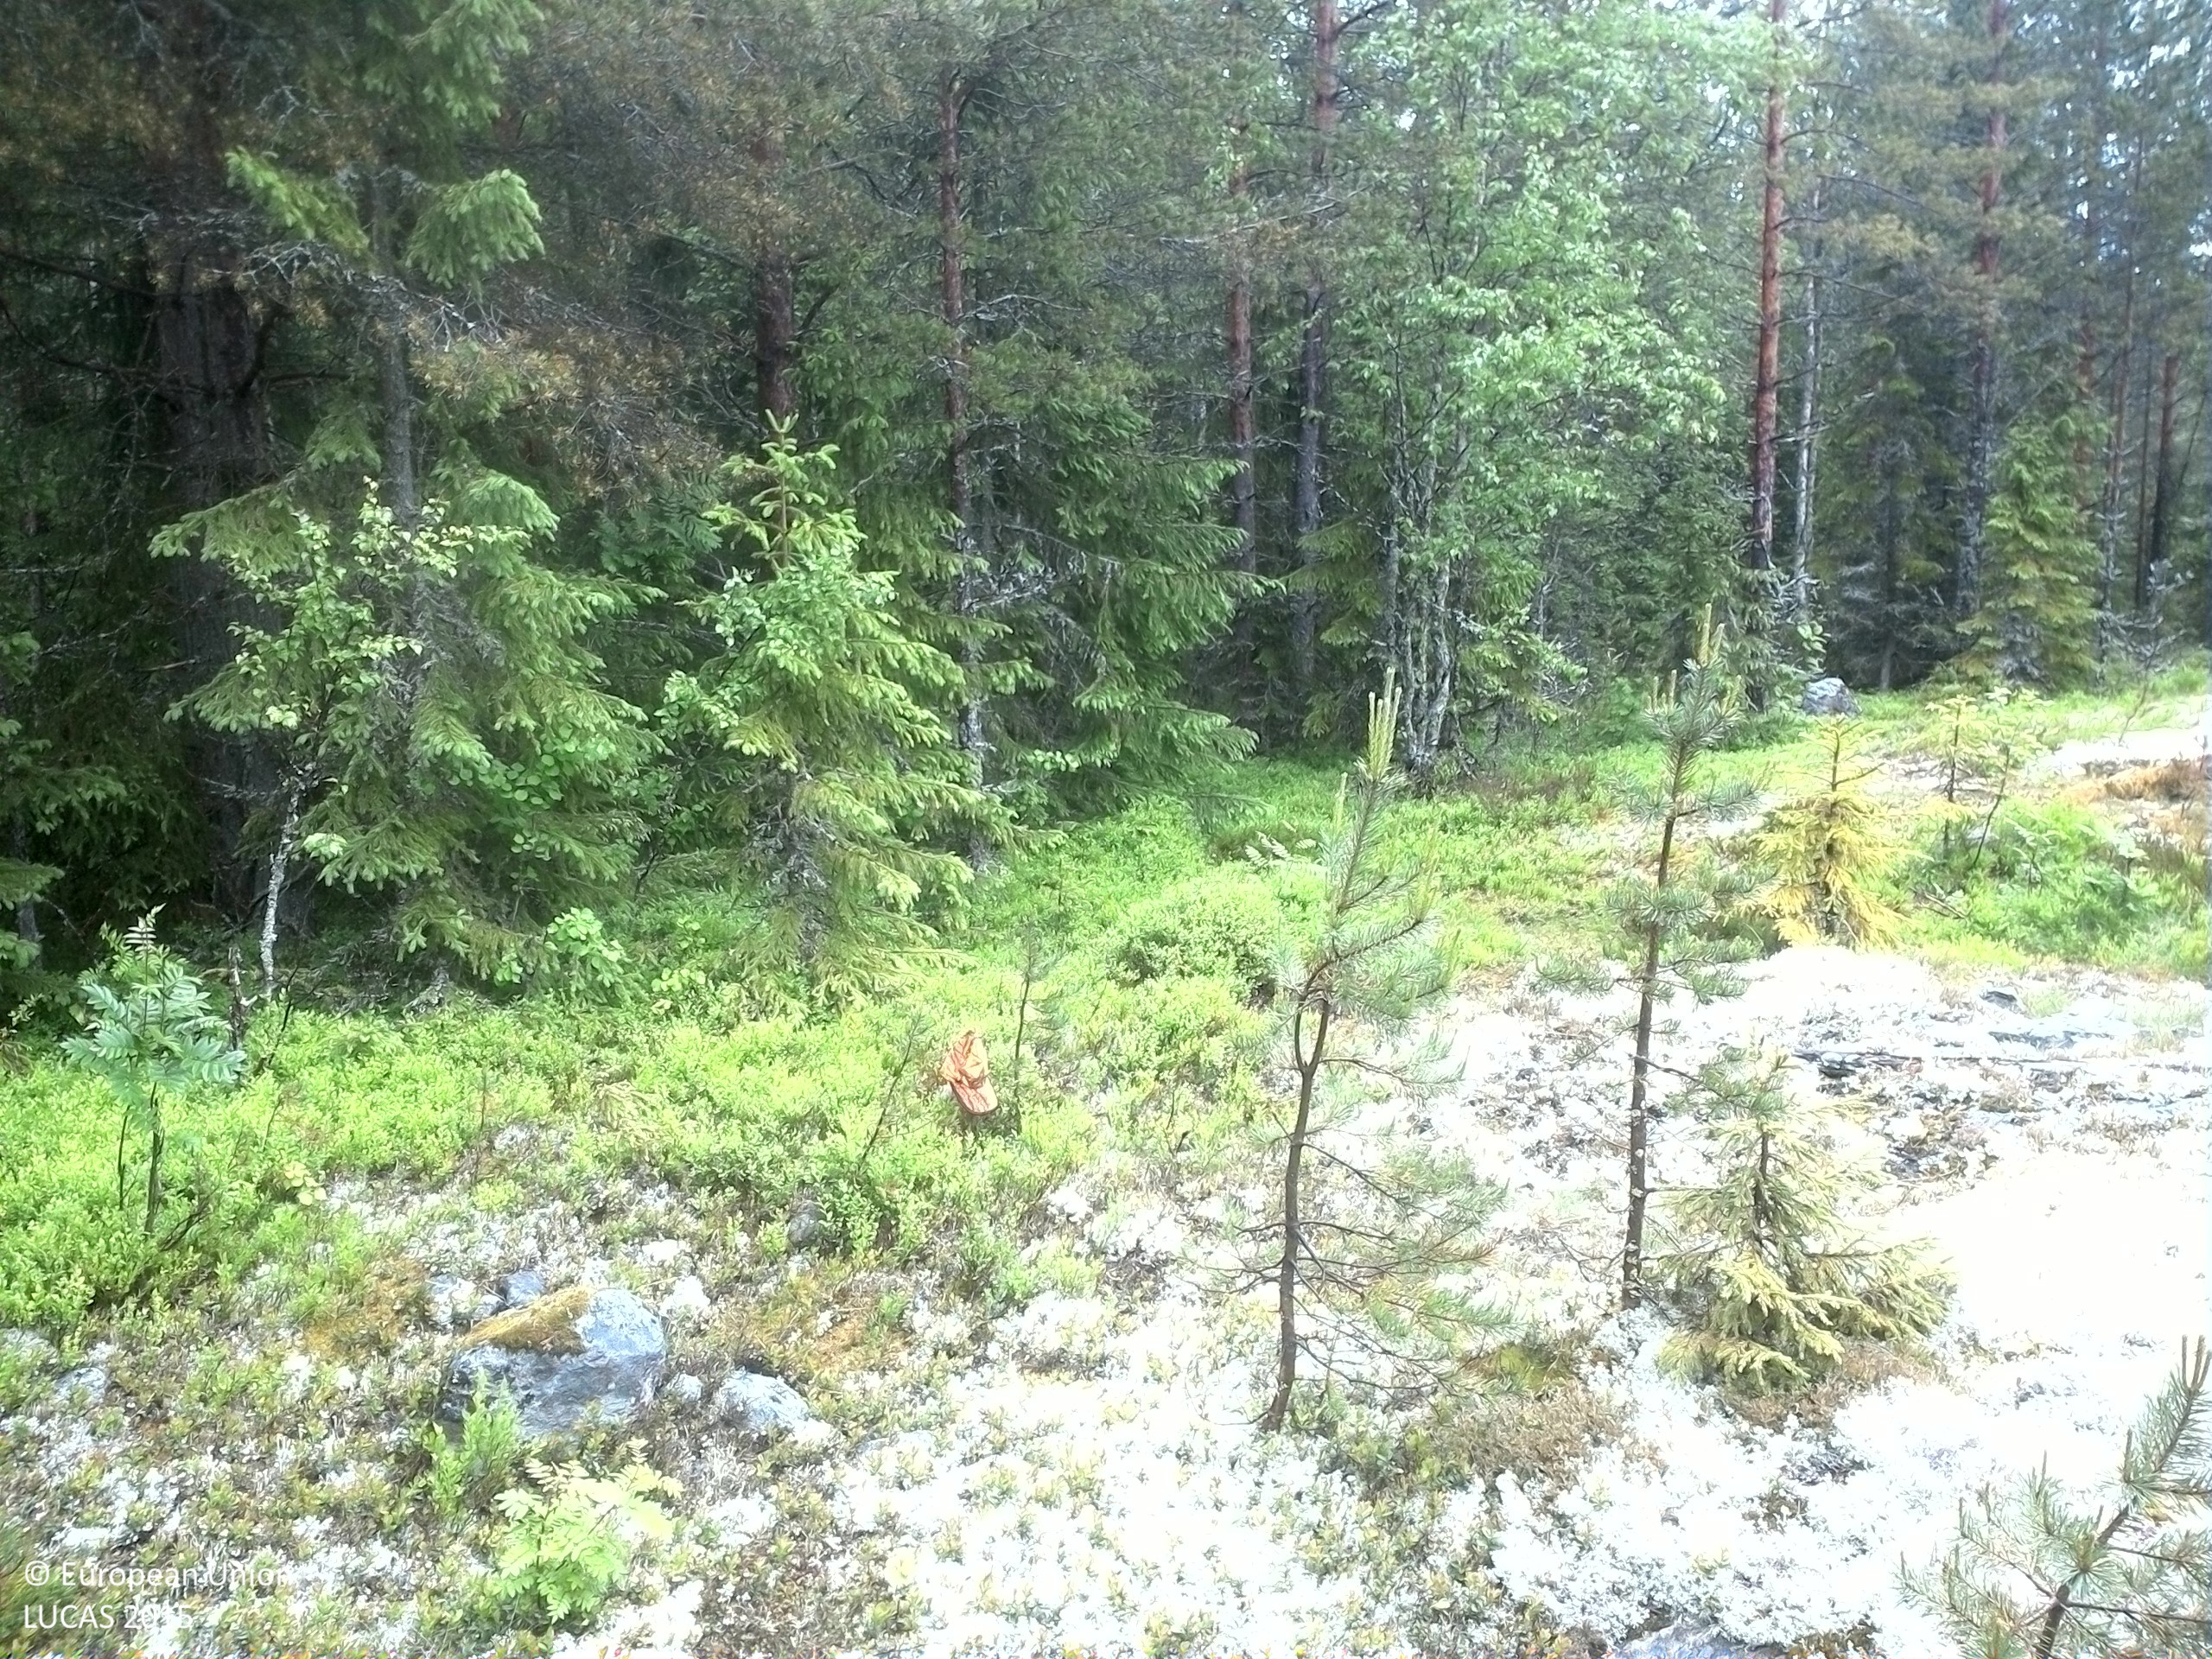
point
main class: Woodland
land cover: Spruce dominated mixed woodland
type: boreal forest
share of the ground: > 75 %
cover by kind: coniferous forest trees 50 %, broadleaved forest trees 30 %, shrubs 20 %
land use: Forestry
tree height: > 5 m
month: June
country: SE
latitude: 62.7469
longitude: 17.9464
